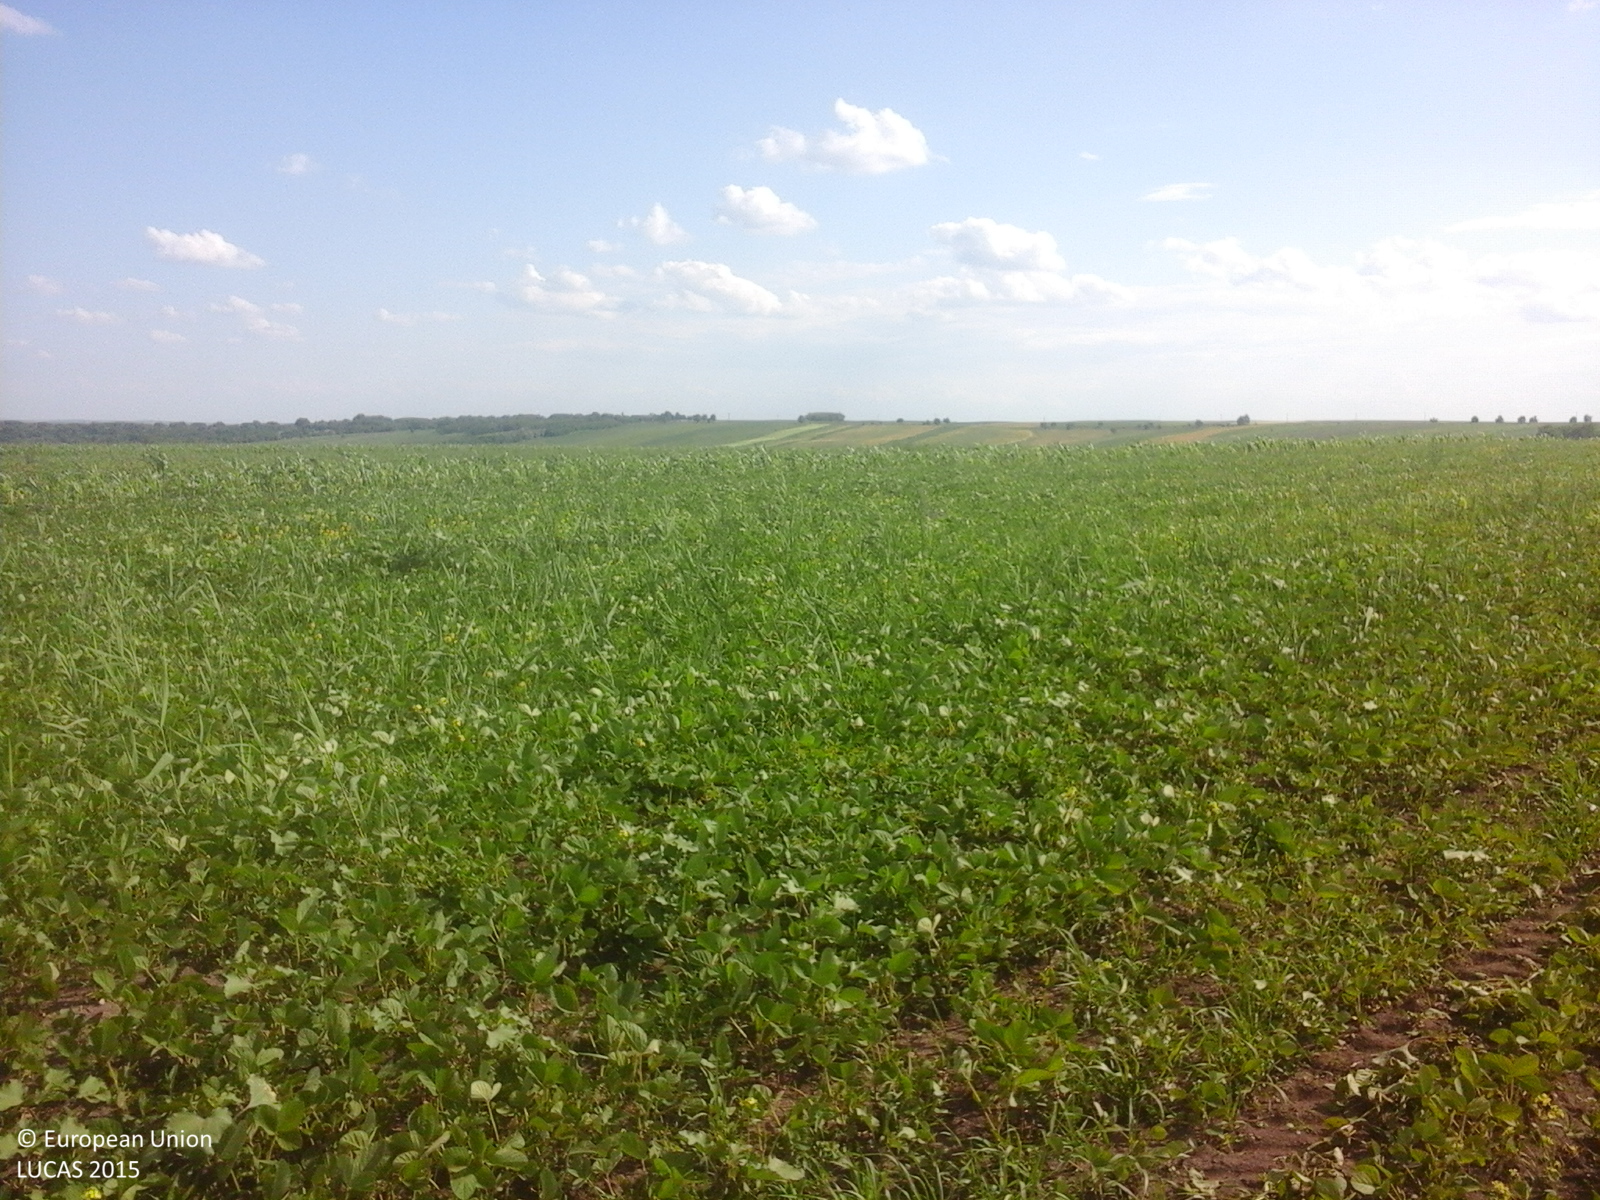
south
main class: Cropland
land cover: Soya
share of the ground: > 75 %
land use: Agriculture (excluding fallow land and kitchen gardens)
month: June
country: RO
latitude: 48.2069
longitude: 26.6903
